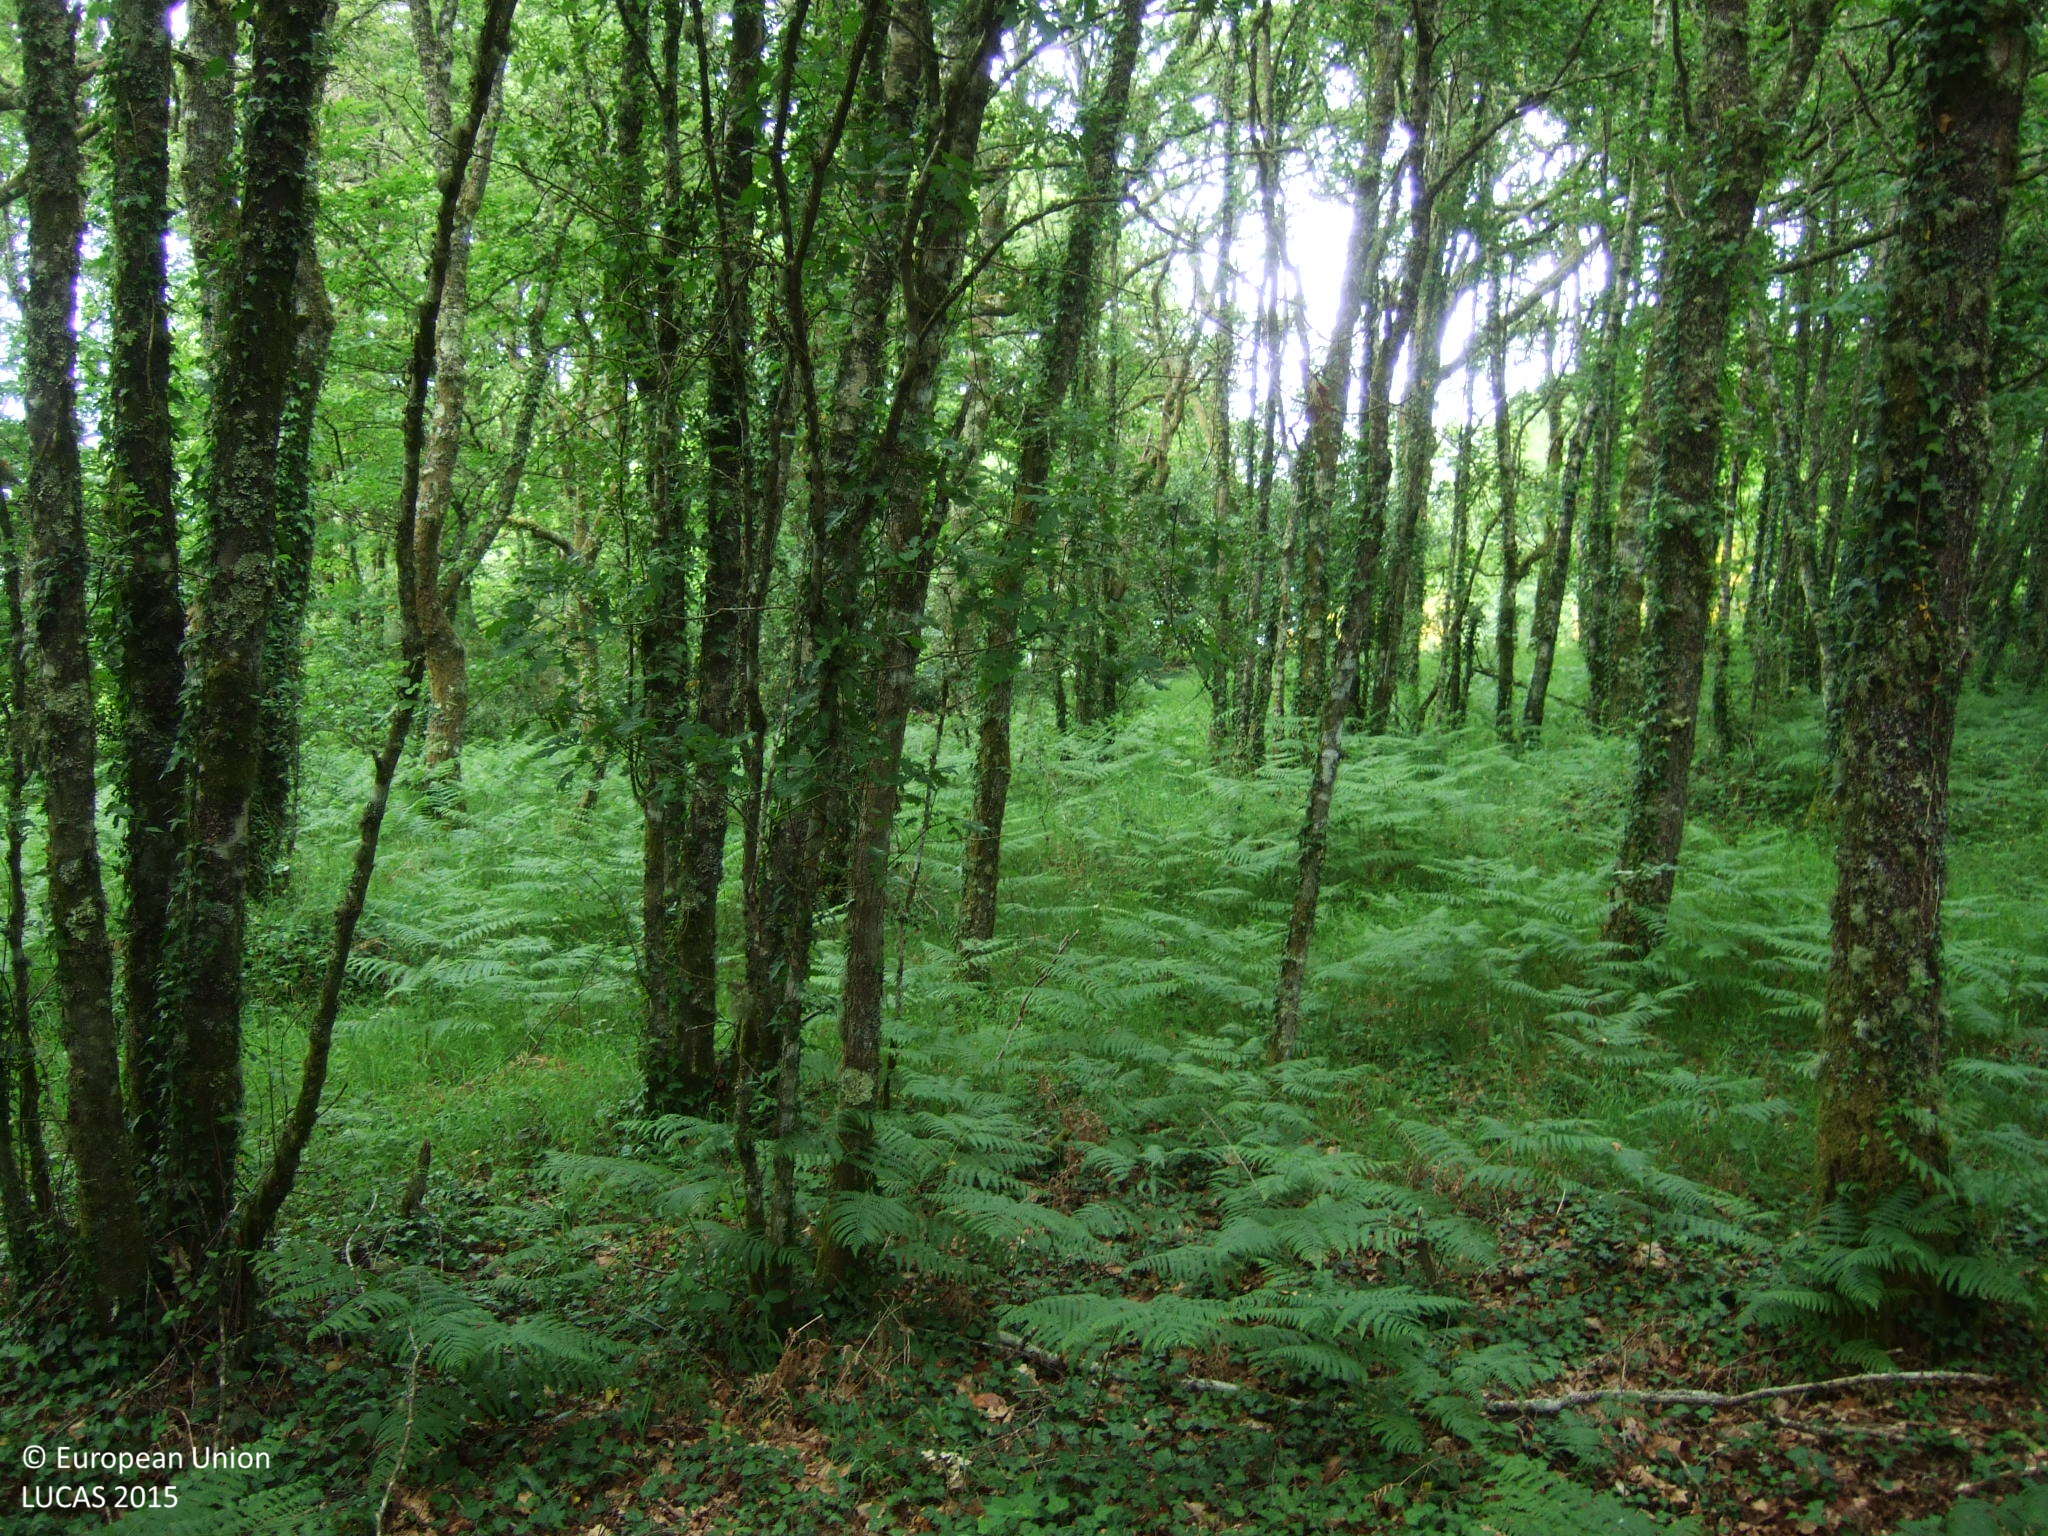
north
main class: Woodland
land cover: Broadleaved woodland
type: acidophilous oak and oak-birch forest
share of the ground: 50 - 75 %
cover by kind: broadleaved forest trees 70 %, shrubs 15 %, herbaceous plants 15 %
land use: Forestry
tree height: > 5 m
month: June
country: ES
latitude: 43.3726
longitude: -7.7733
